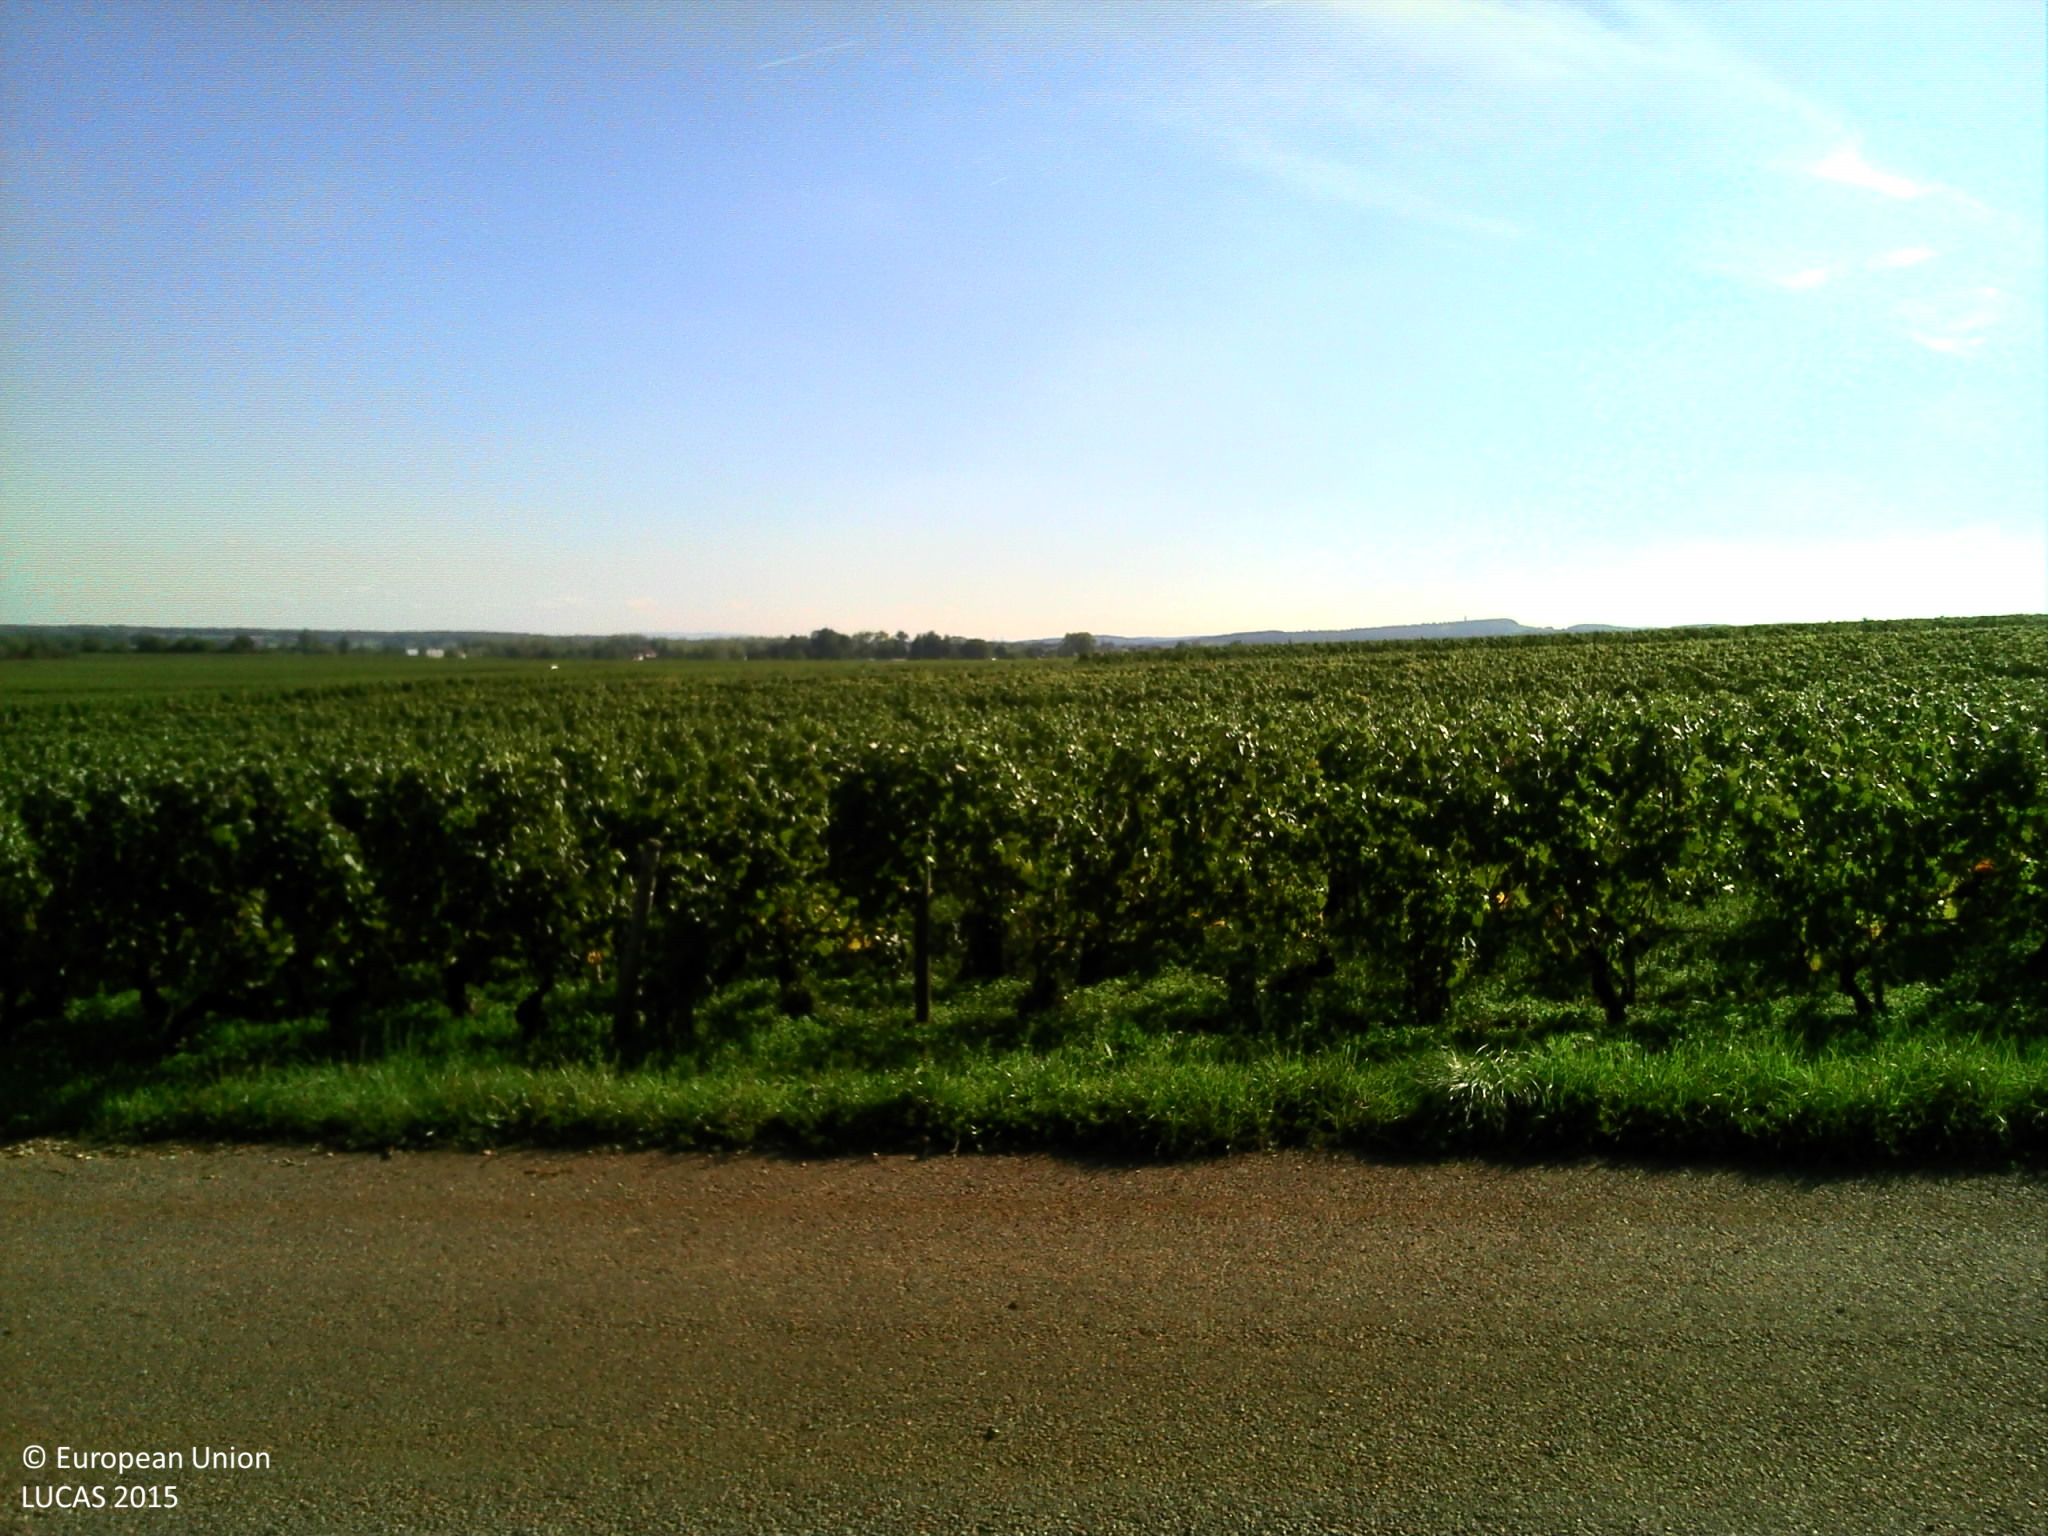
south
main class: Cropland
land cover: Vineyards
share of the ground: > 75 %
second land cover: Spontaneously vegetated surfaces
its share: > 75 %
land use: Agriculture (excluding fallow land and kitchen gardens)
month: September
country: FR
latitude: 46.9625
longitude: 4.7571
